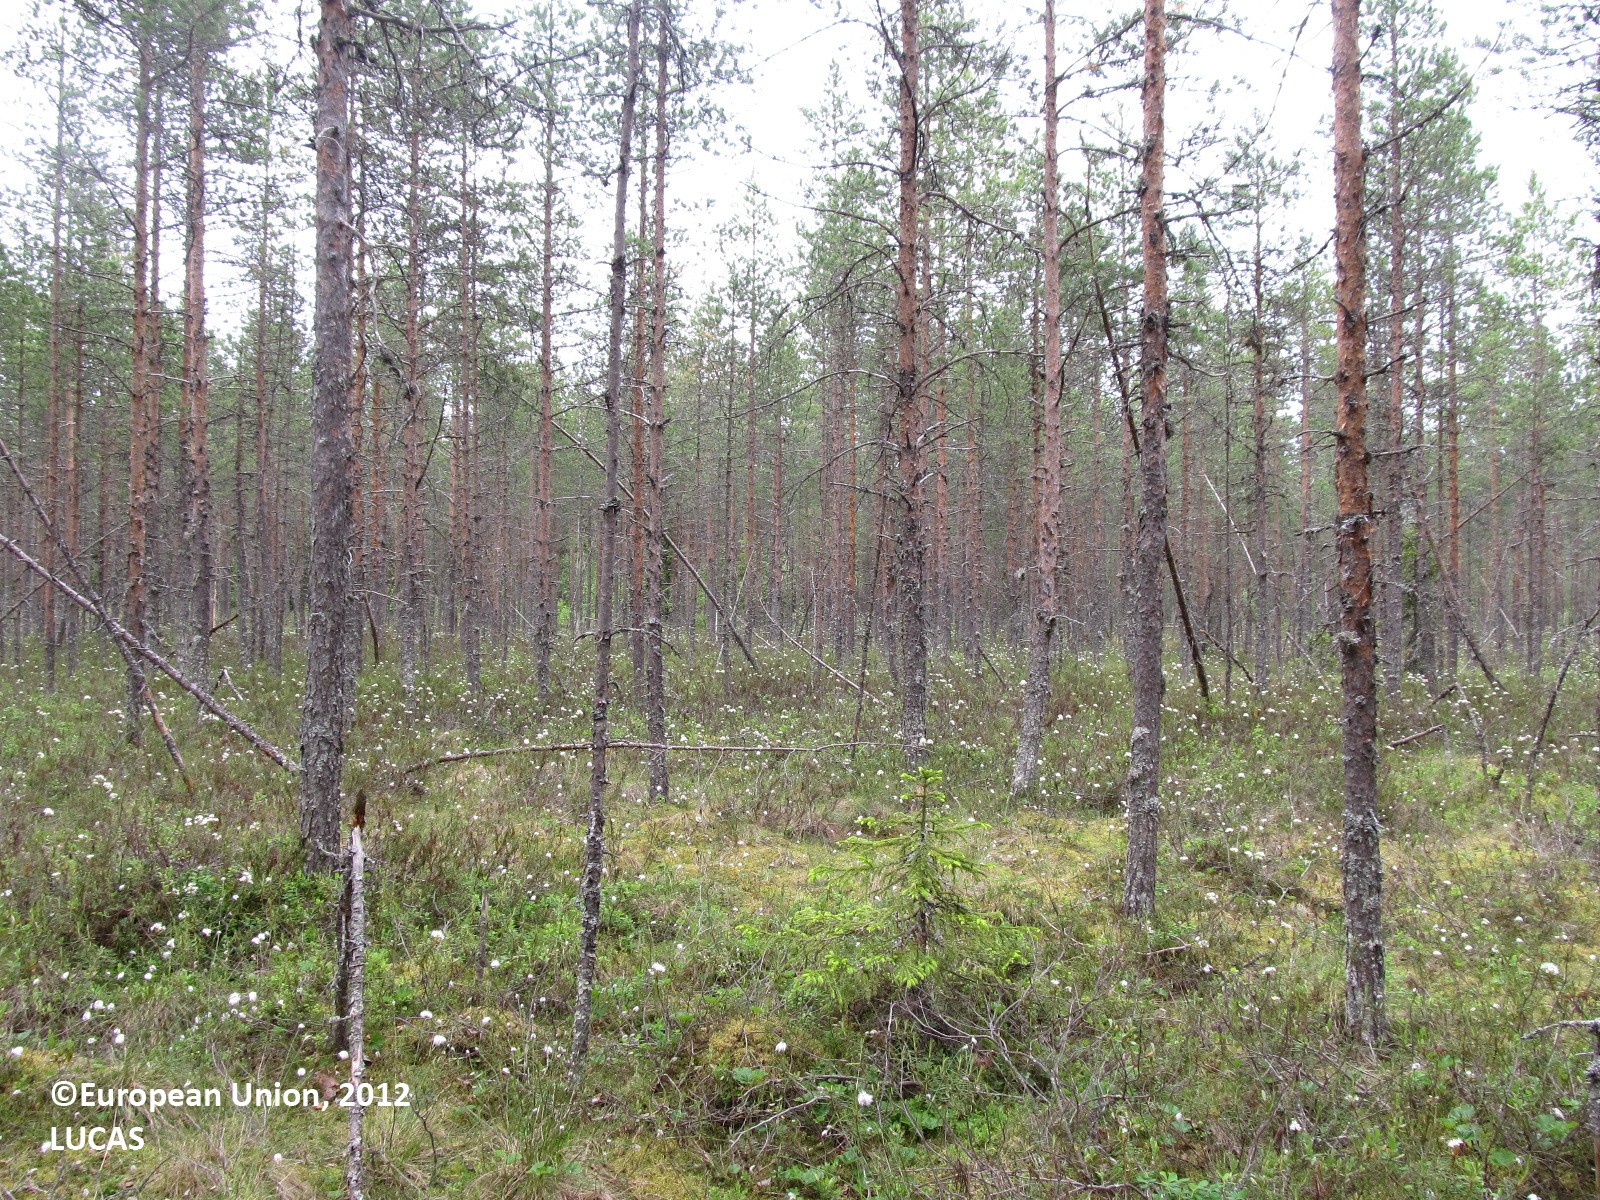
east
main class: Woodland
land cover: Pine dominated coniferous woodland
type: boreal forest
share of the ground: 25 - 50 %
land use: Forestry
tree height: > 5 m
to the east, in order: Pine dominated coniferous woodland; Ditches and canals; Pine dominated coniferous woodland; Ditches and canals; Pine dominated mixed woodland; Spruce dominated mixed woodland
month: June
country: FI
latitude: 63.3010
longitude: 27.8237
